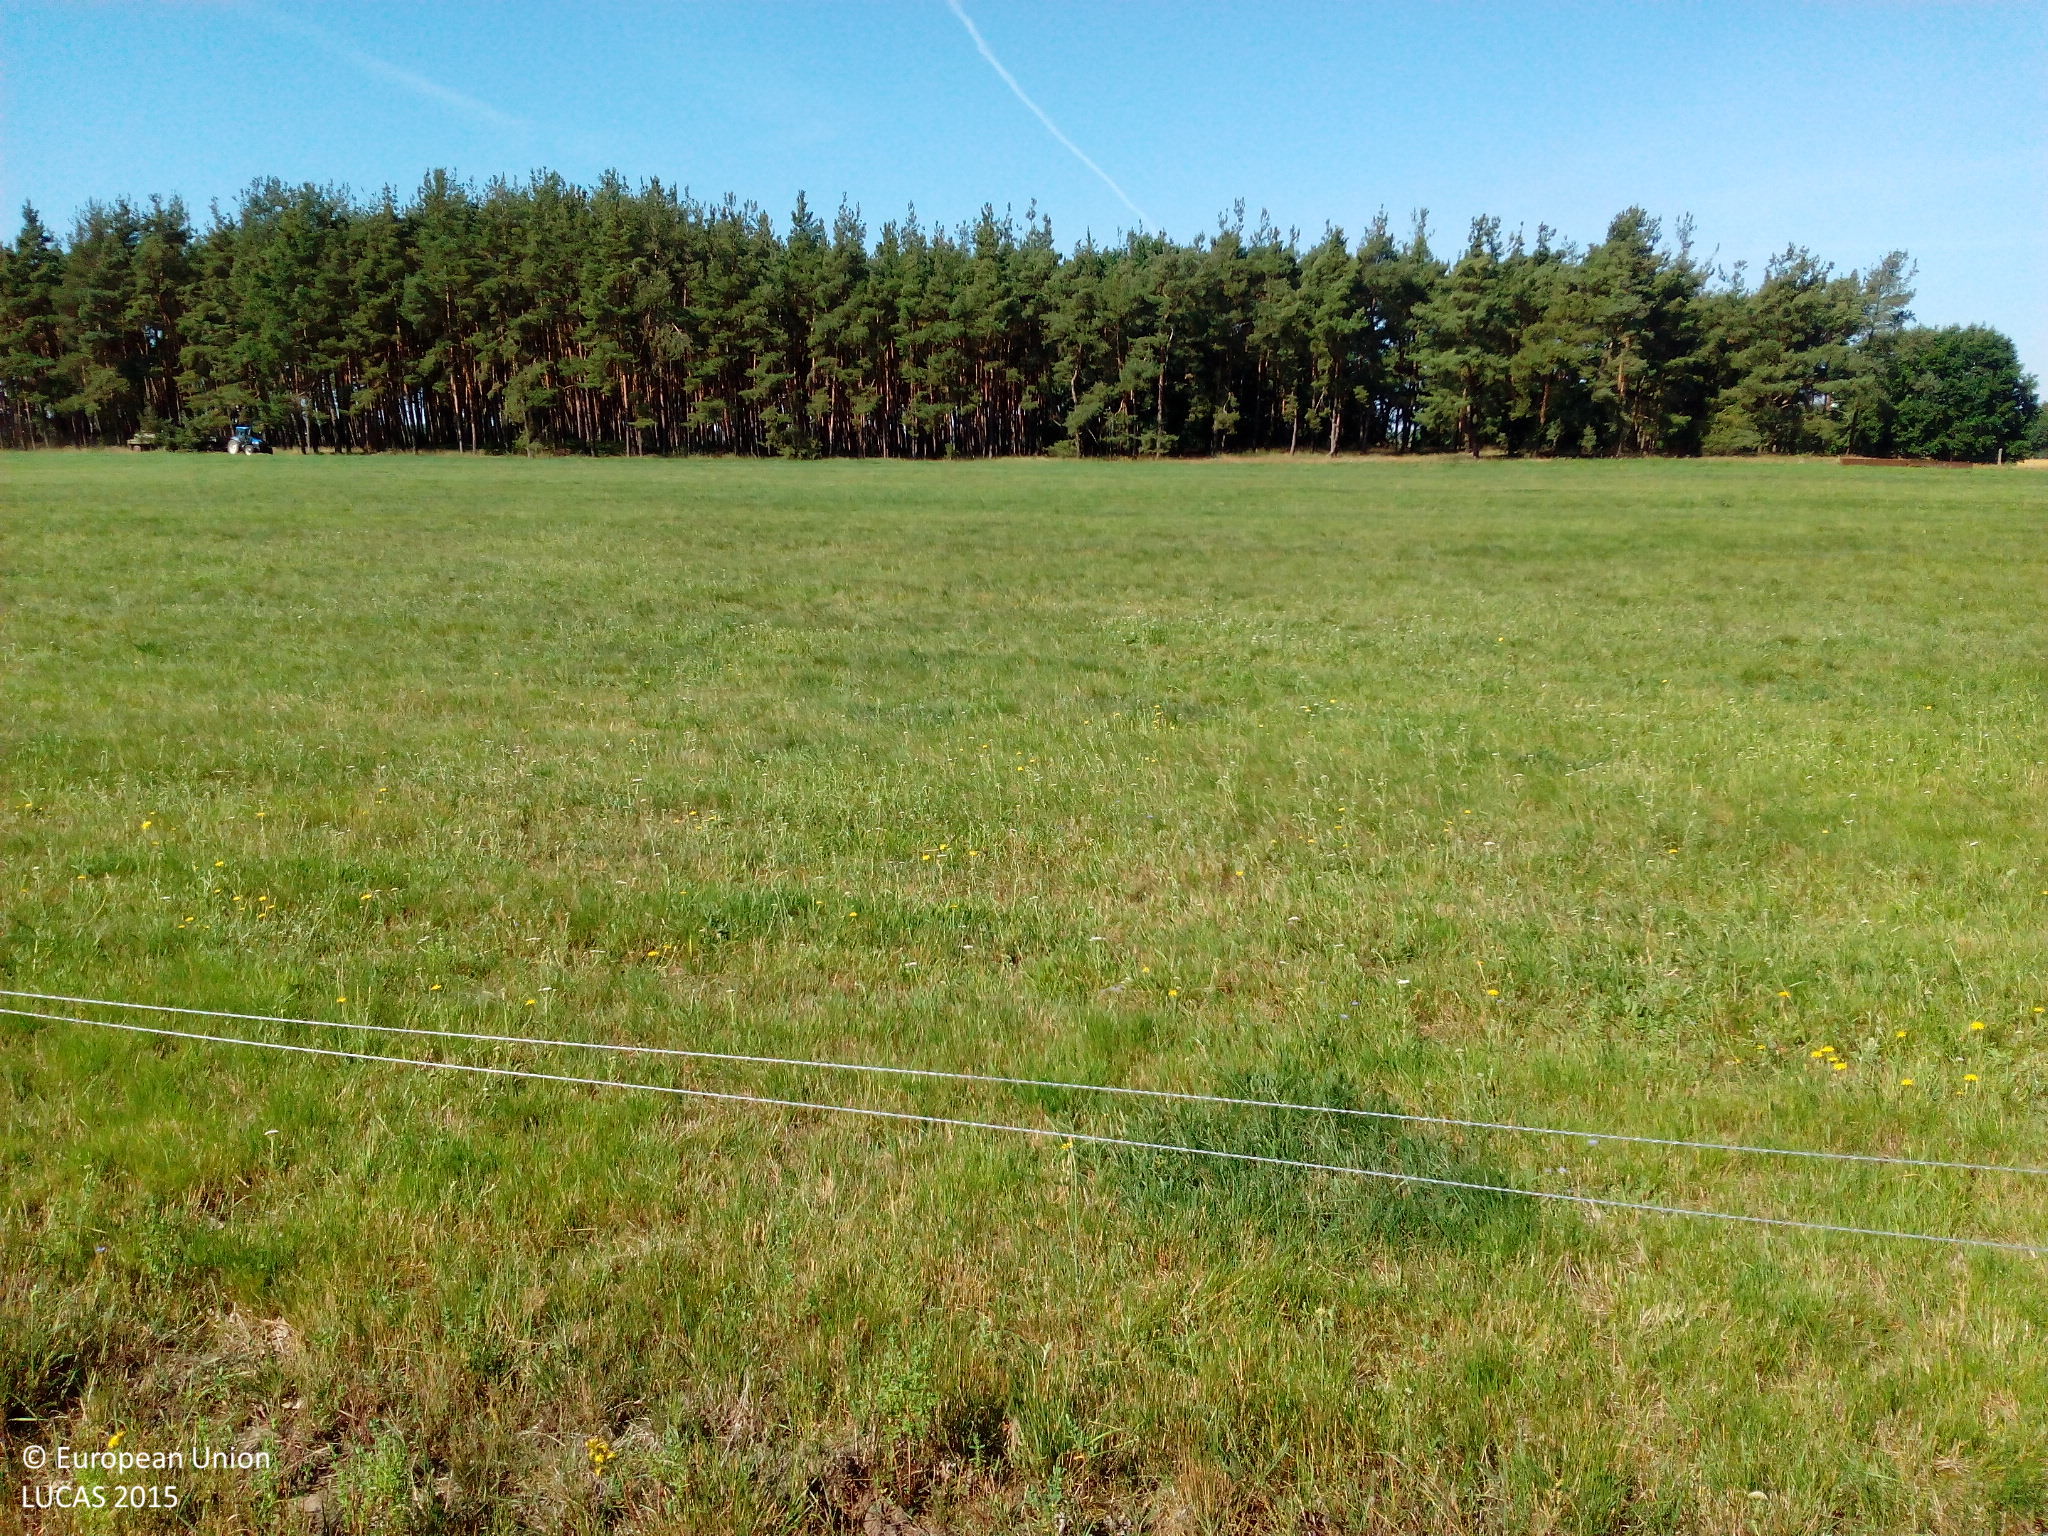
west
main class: Grassland
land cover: Grassland without tree/shrub cover
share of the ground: > 75 %
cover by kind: herbaceous plants 100 %
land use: Agriculture (excluding fallow land and kitchen gardens)
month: August
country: DE
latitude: 52.7193
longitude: 12.0573
